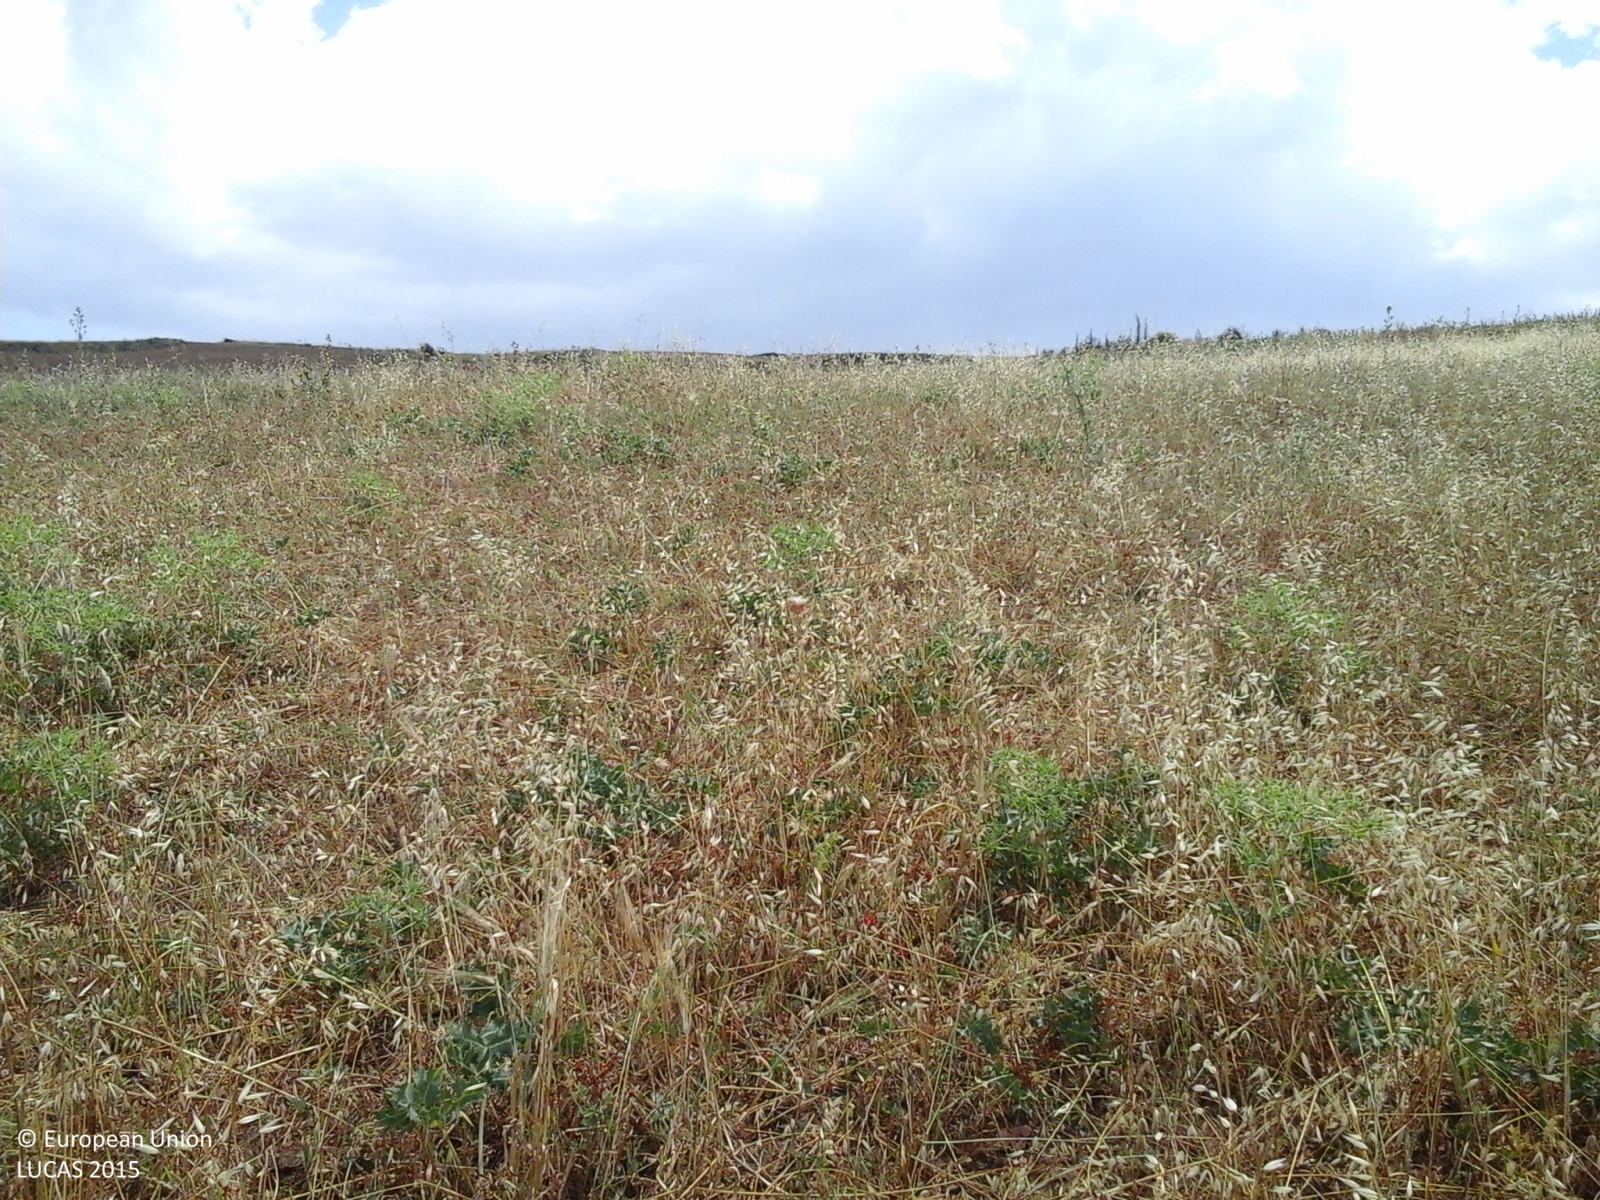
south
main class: Grassland
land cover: Spontaneously vegetated surfaces
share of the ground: > 75 %
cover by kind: herbaceous plants 100 %
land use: Fallow land
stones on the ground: < 10 %
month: June
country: IT
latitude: 37.9007
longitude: 13.5117
